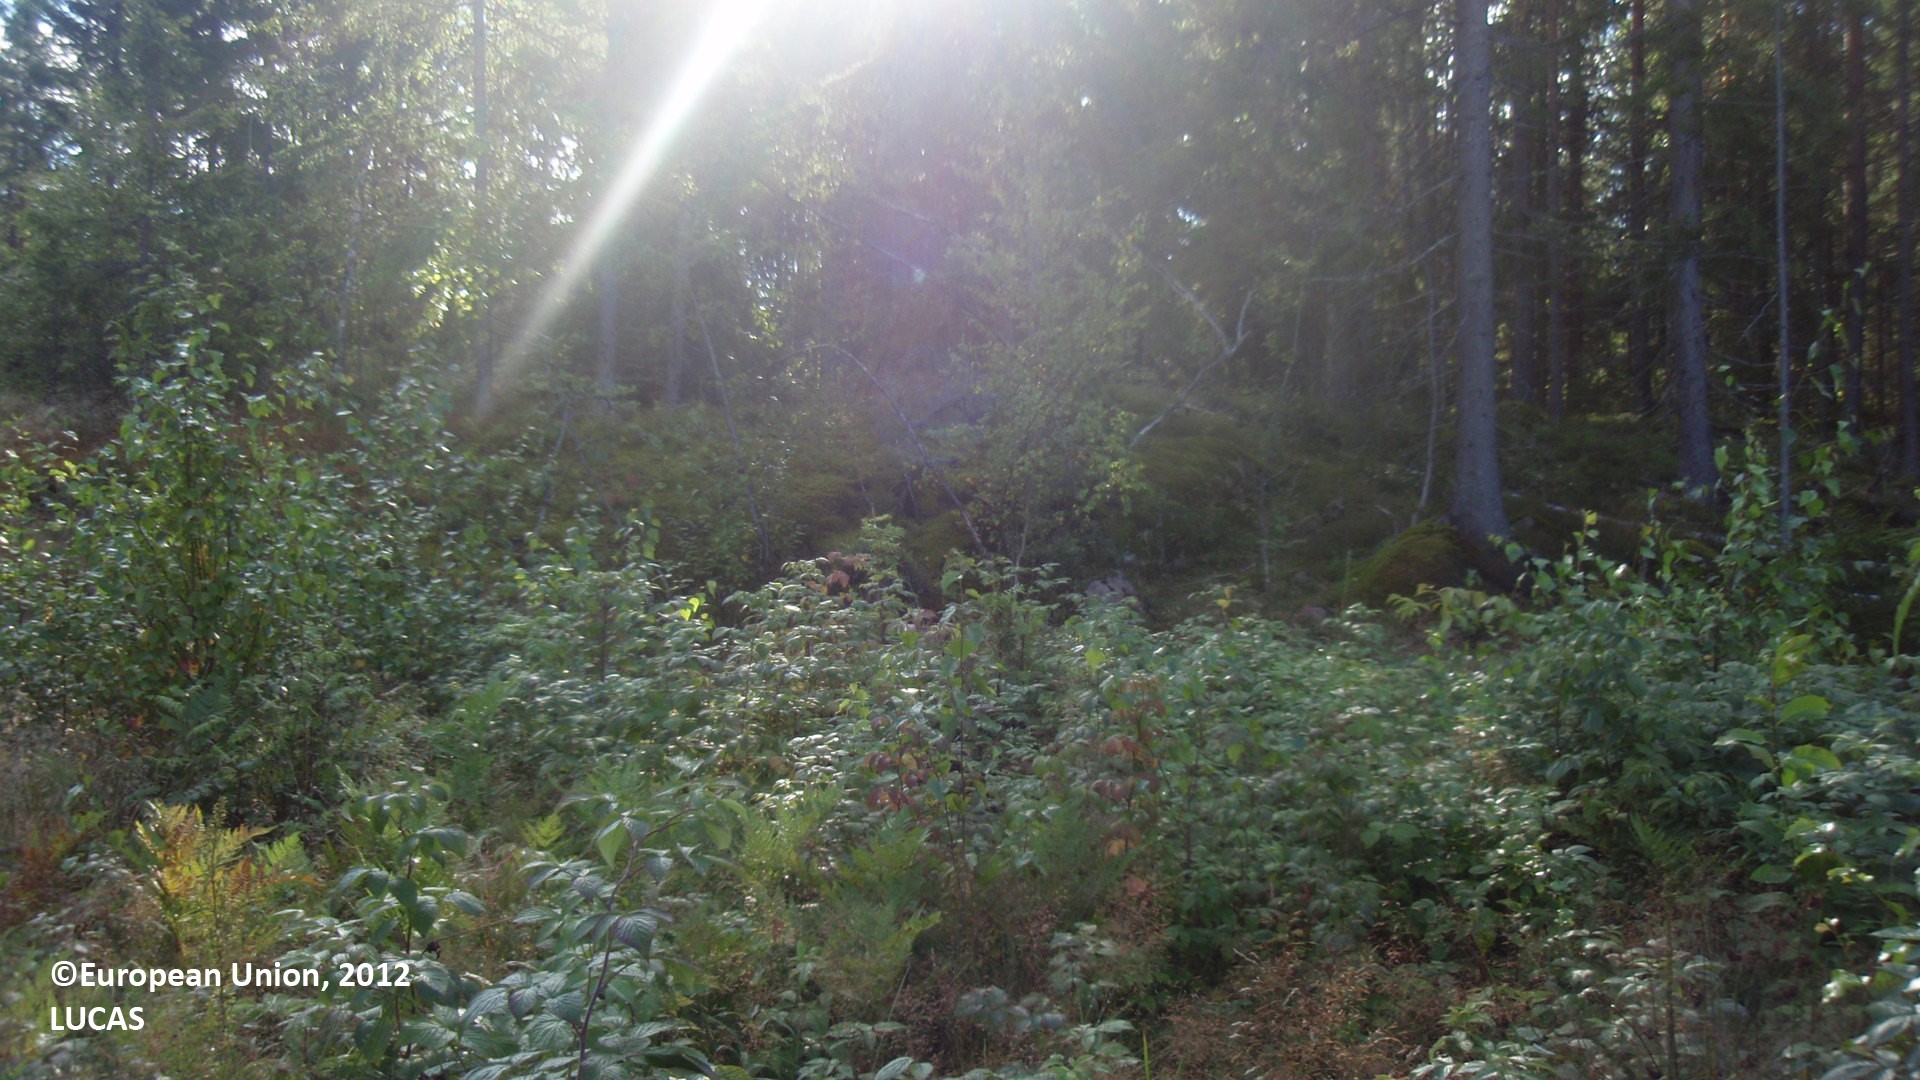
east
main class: Shrubland
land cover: Shrubland with sparse tree cover
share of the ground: > 75 %
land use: Forestry
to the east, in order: Shrubland with sparse tree cover; Pine dominated mixed woodland; Lichens and moss; Pine dominated mixed woodland; Tracks; Pine dominated coniferous woodland; Ditches and canals; Pine dominated mixed woodland
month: August
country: FI
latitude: 60.6509
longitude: 27.1666
